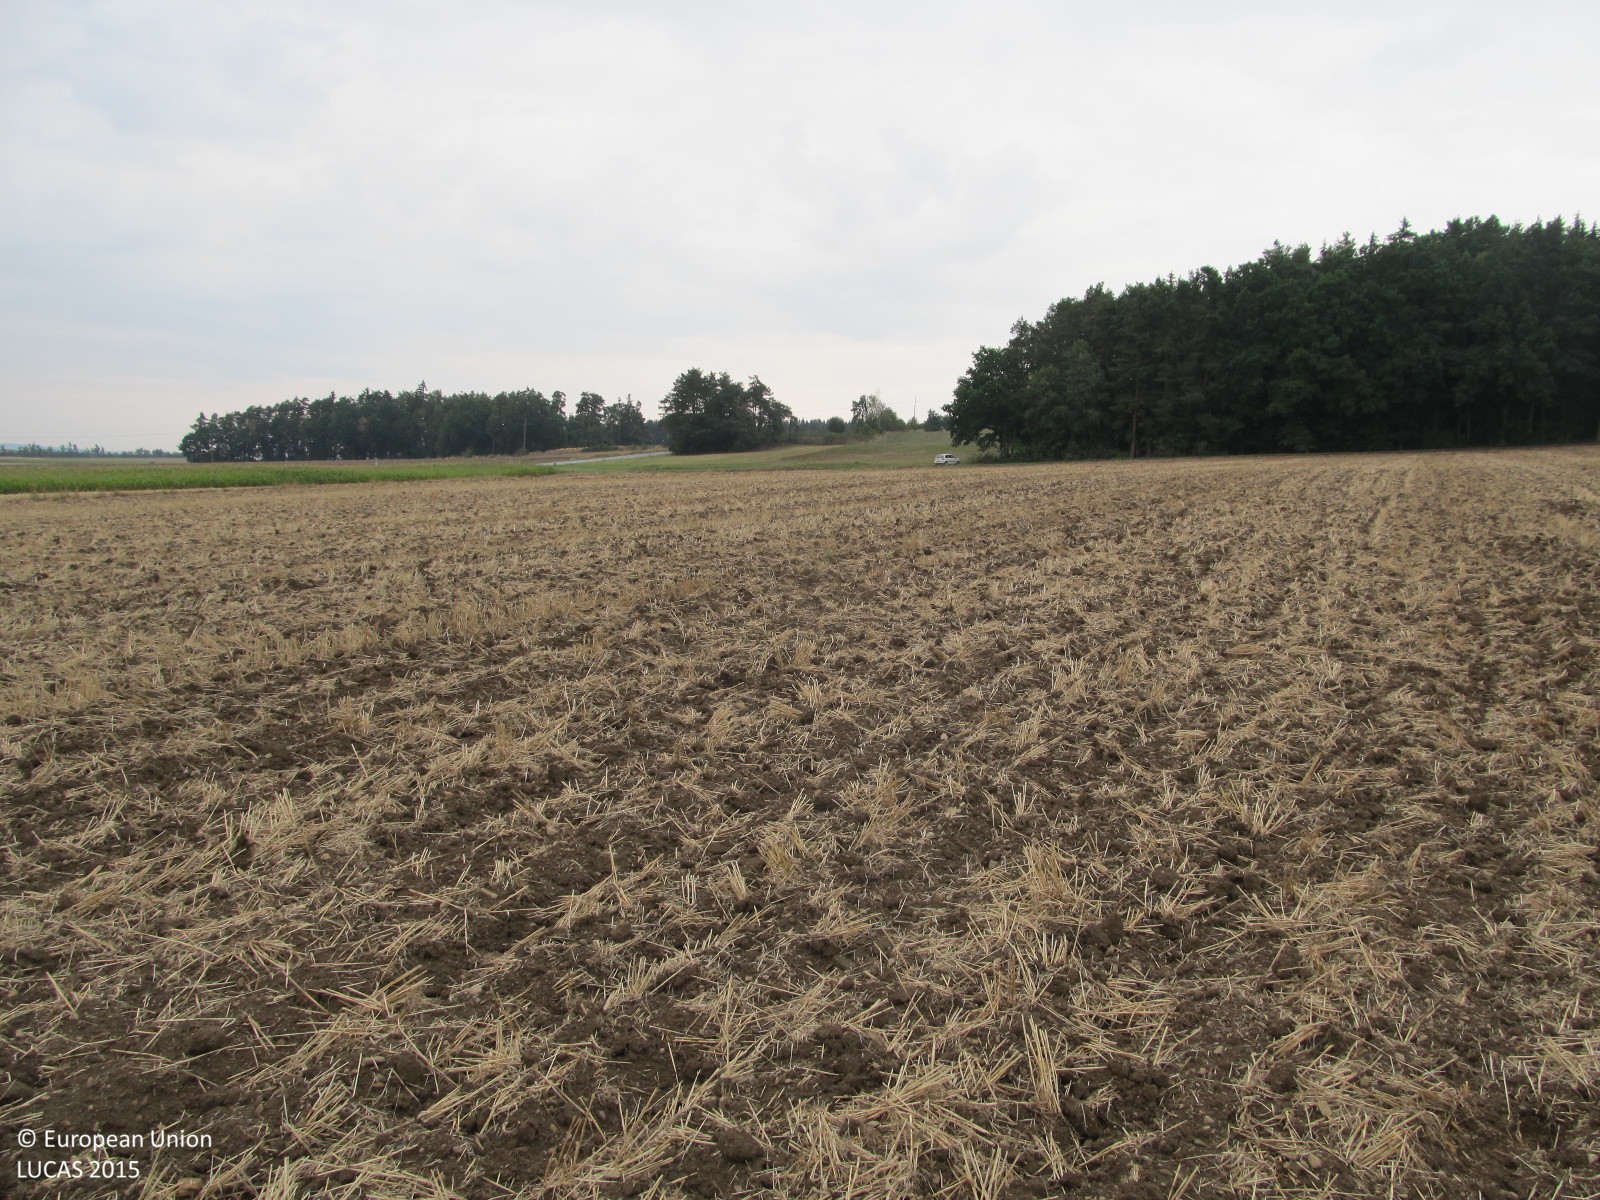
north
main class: Cropland
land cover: Barley
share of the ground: < 10 %
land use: Agriculture (excluding fallow land and kitchen gardens)
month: August
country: AT
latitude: 48.8605
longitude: 15.5237
